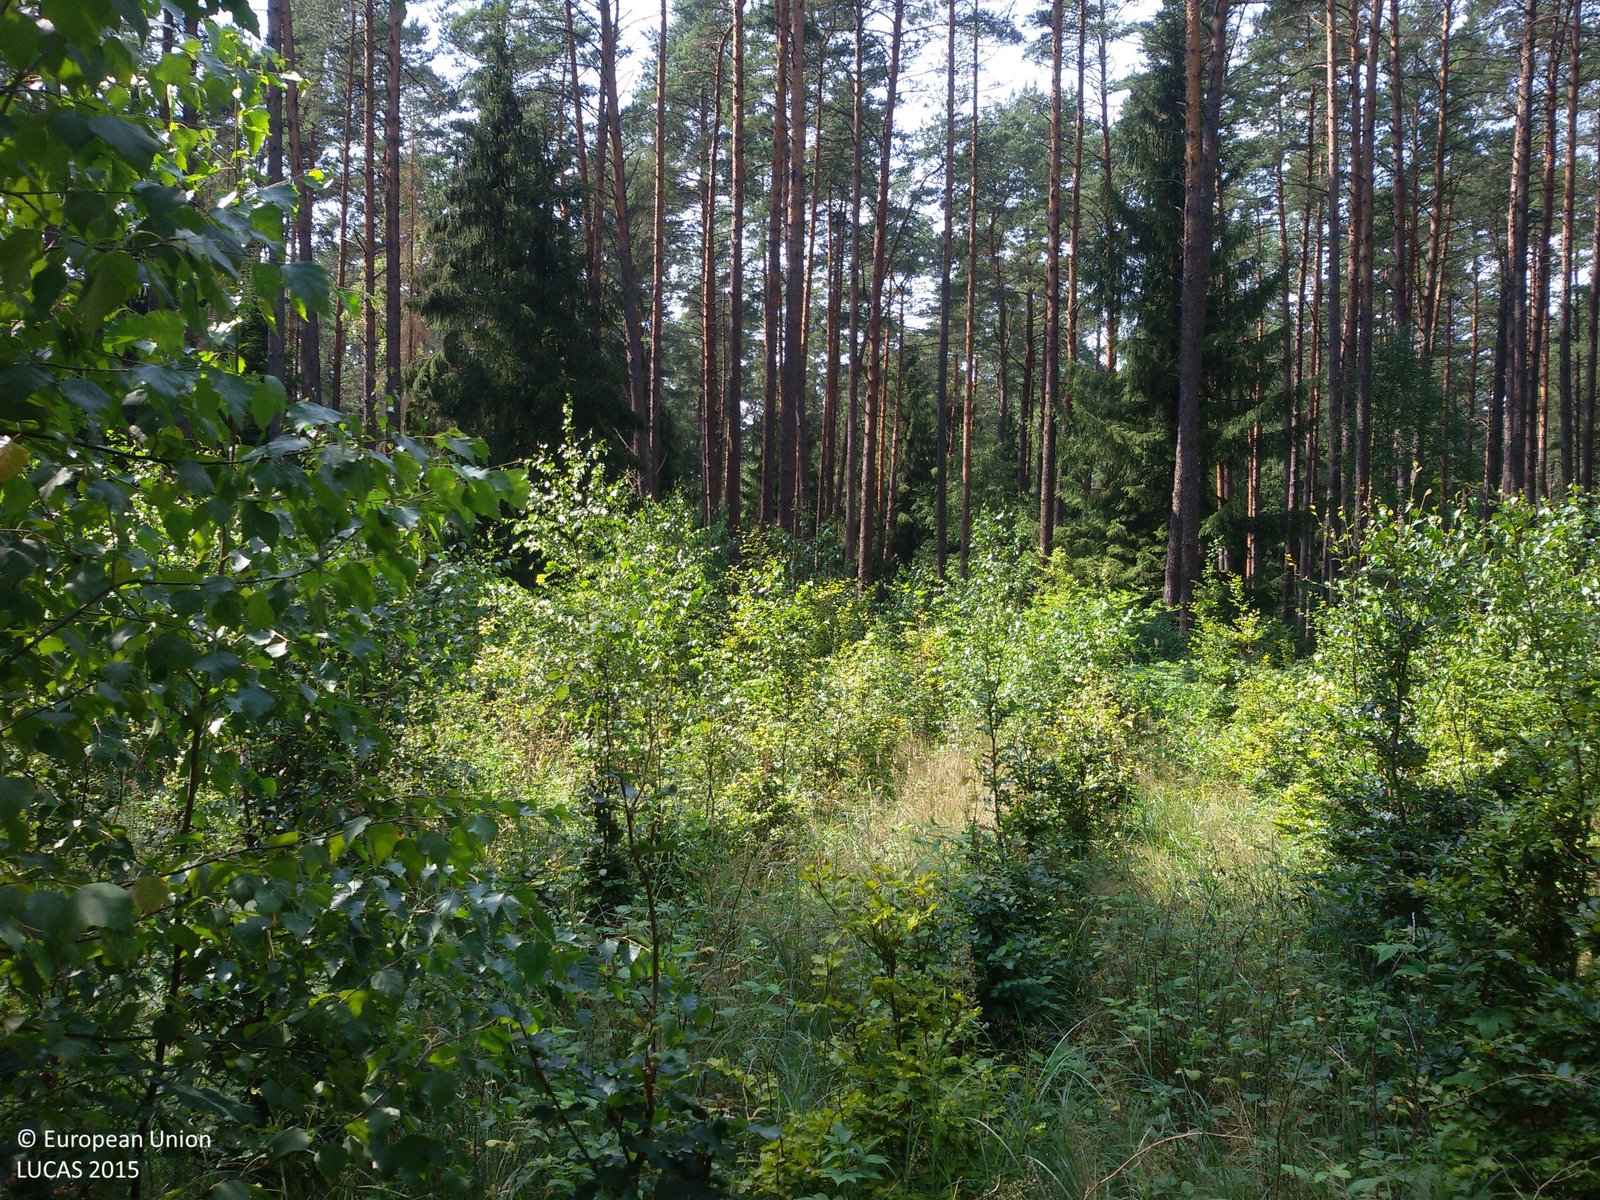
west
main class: Woodland
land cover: Broadleaved woodland
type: mesophytic deciduous forest
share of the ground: > 75 %
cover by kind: broadleaved forest trees 75 %, herbaceous plants 25 %
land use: Forestry
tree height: > 5 m
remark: Nursery
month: August
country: PL
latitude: 53.7308
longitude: 17.7587
